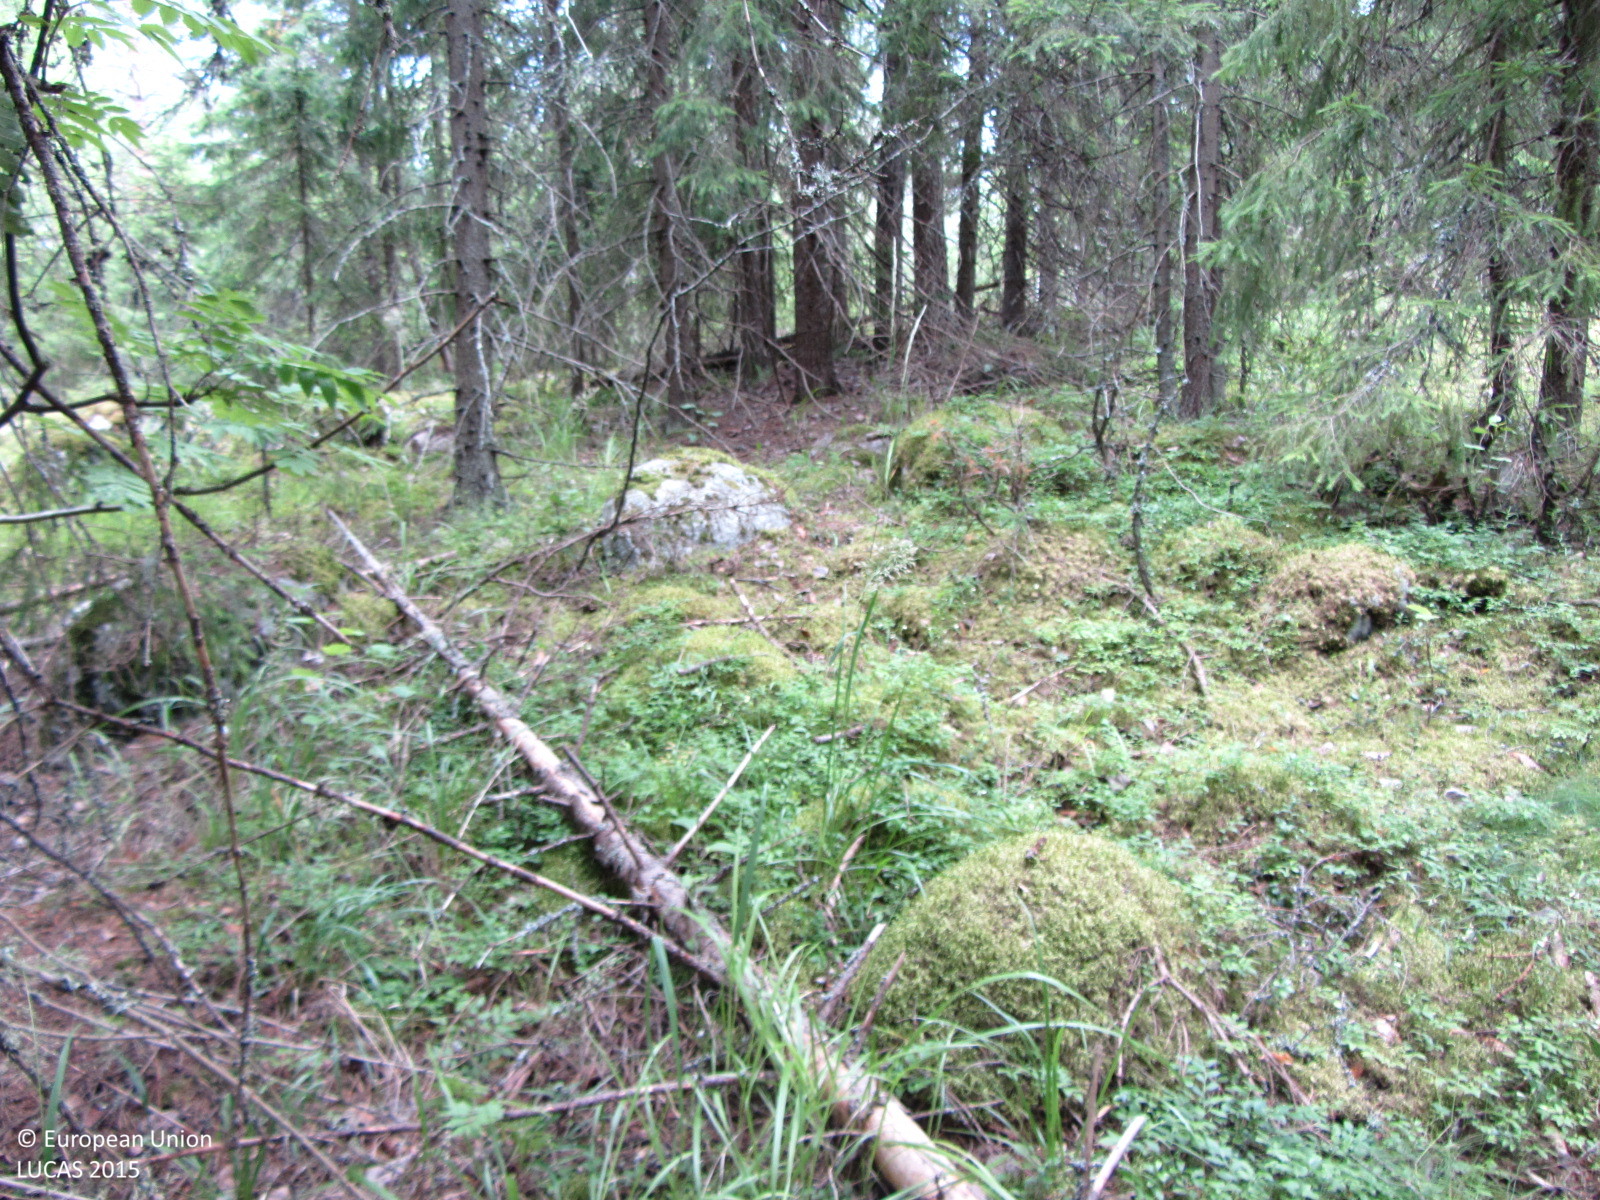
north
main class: Woodland
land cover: Spruce dominated coniferous woodland
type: boreal forest
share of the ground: > 75 %
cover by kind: coniferous forest trees 65 %, broadleaved forest trees 10 %, shrubs 10 %, herbaceous plants 5 %, lichens and mosses 5 %, consolidated bare surface 5 %
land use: Forestry
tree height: > 5 m
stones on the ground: 10 - 25 %
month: July
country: FI
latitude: 60.6341
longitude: 24.5297
